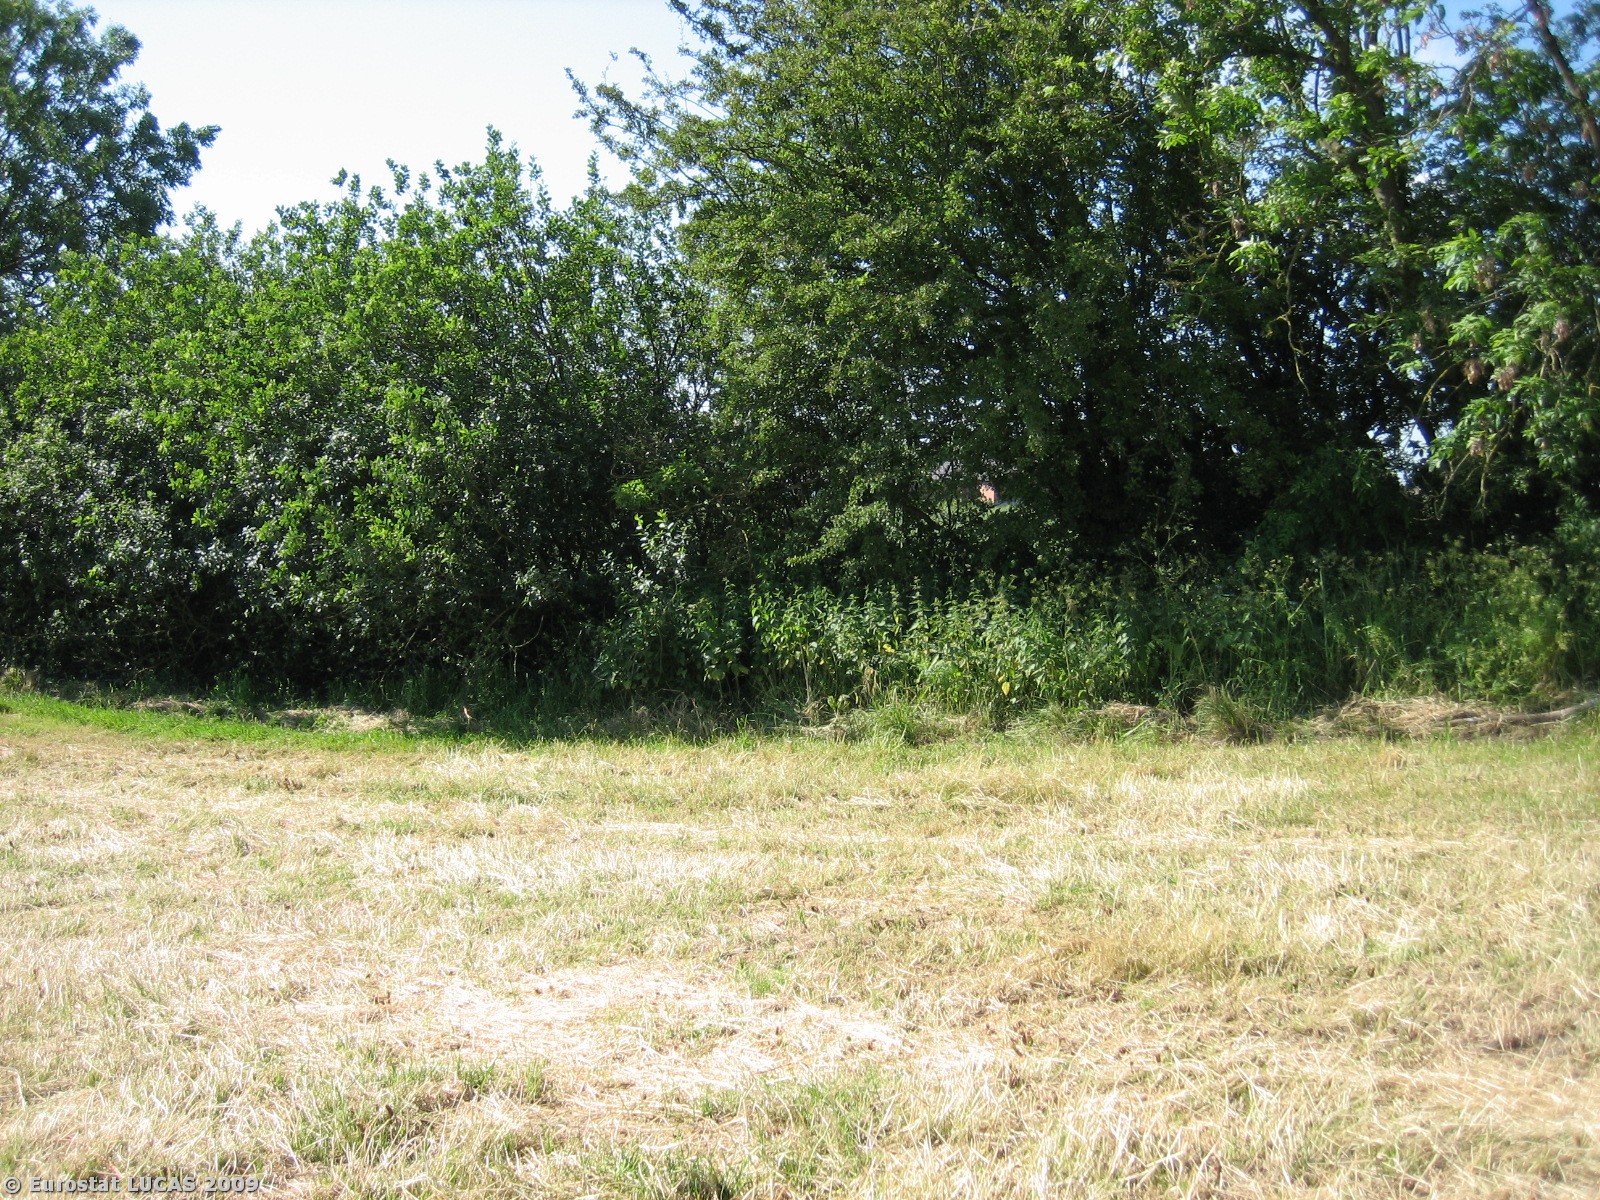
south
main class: Cropland
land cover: Temporary grasslands
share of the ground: > 75 %
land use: Agriculture (excluding fallow land and kitchen gardens)
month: June
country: DK
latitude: 55.3949
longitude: 9.2902
